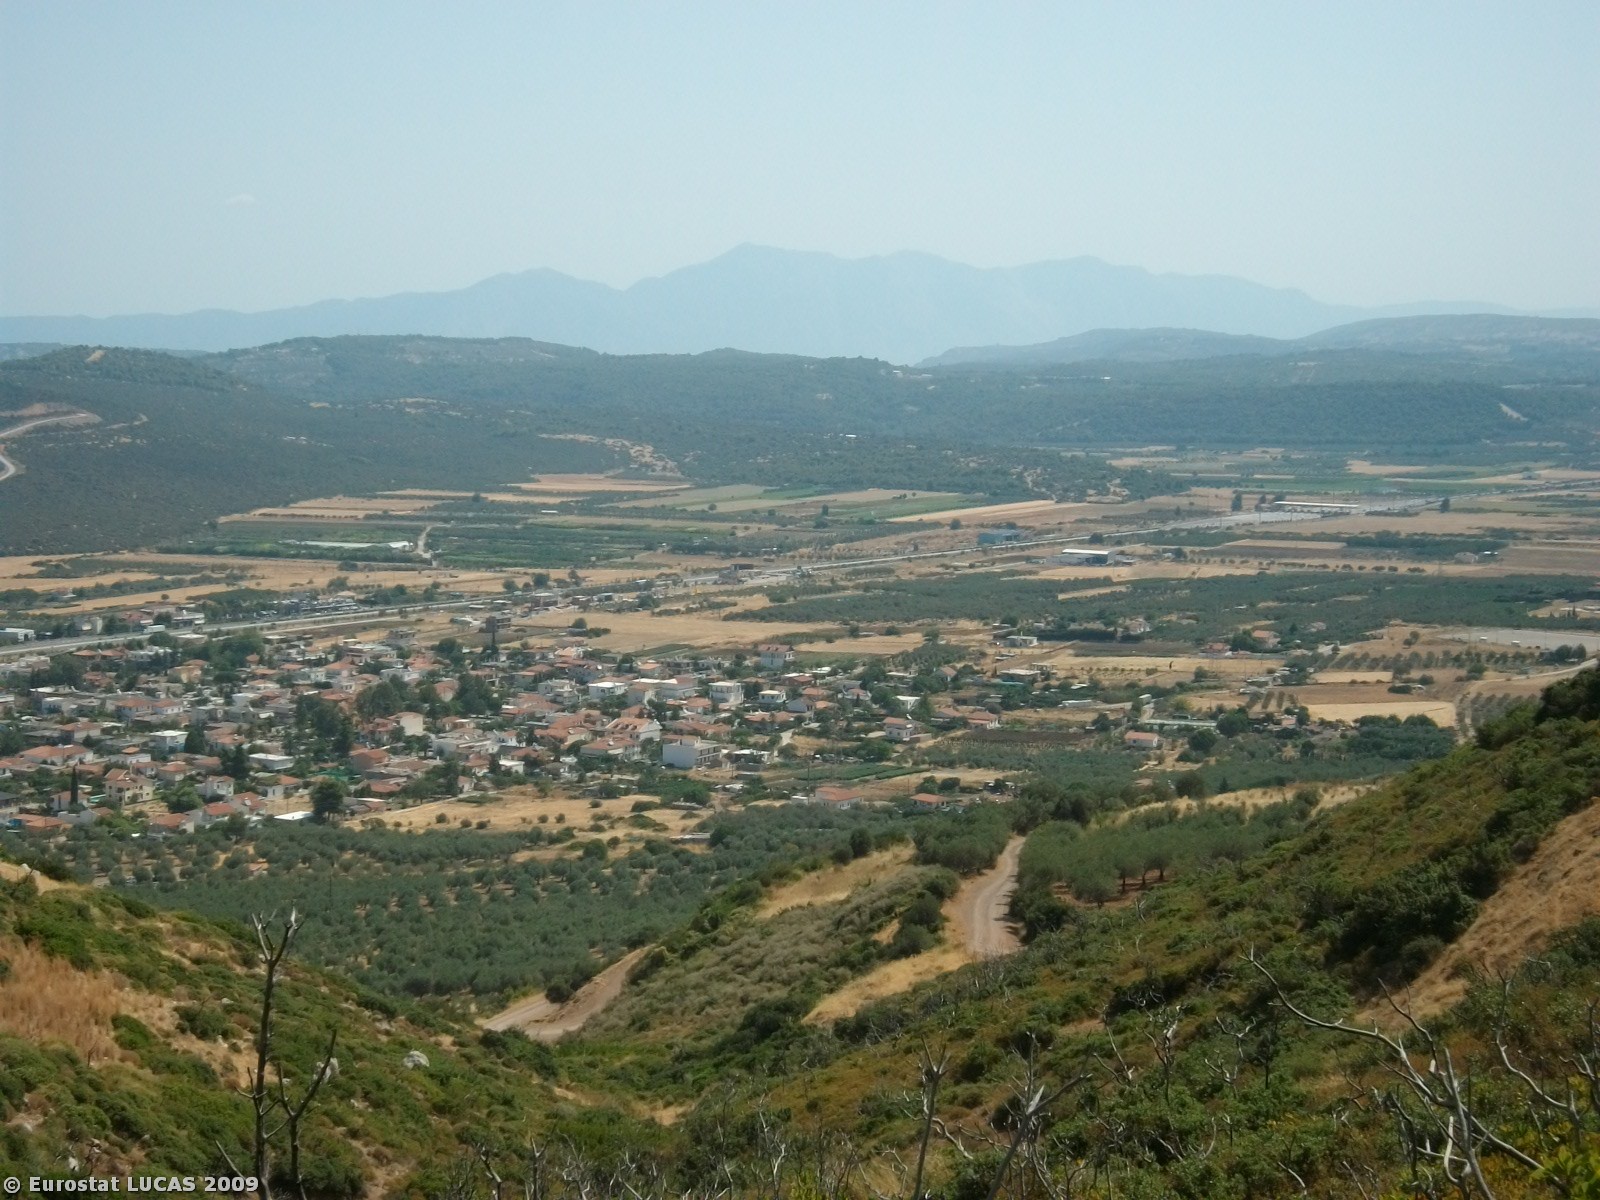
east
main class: Shrubland
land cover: Shrubland without tree cover
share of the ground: > 75 %
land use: Unused
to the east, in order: Shrubland without tree cover; Paved roads, cycling and walking lanes; Grass margins; Shrubland without tree cover
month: August
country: GR
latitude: 38.6143
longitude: 23.1100
